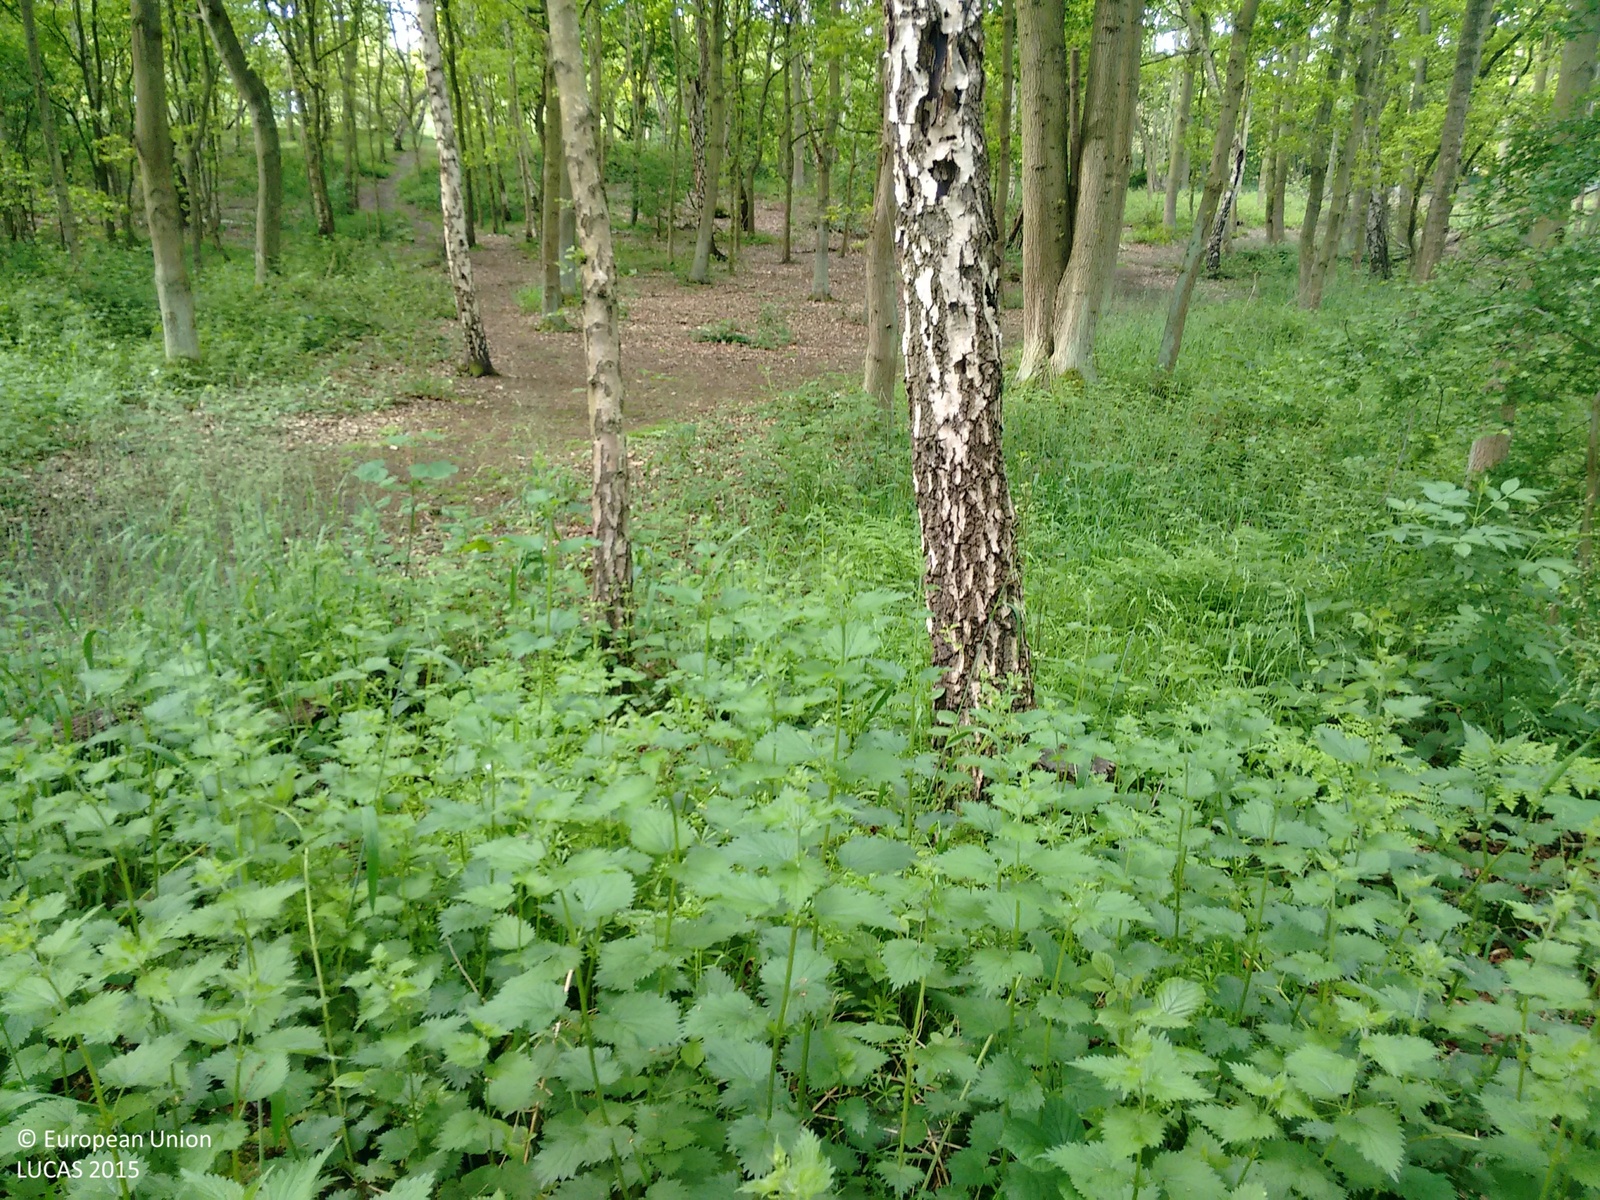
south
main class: Woodland
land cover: Broadleaved woodland
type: mesophytic deciduous forest
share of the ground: > 75 %
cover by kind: broadleaved forest trees 100 %
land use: Amenities, museums, leisure
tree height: > 5 m
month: May
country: GB
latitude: 53.4420
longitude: -1.0187
